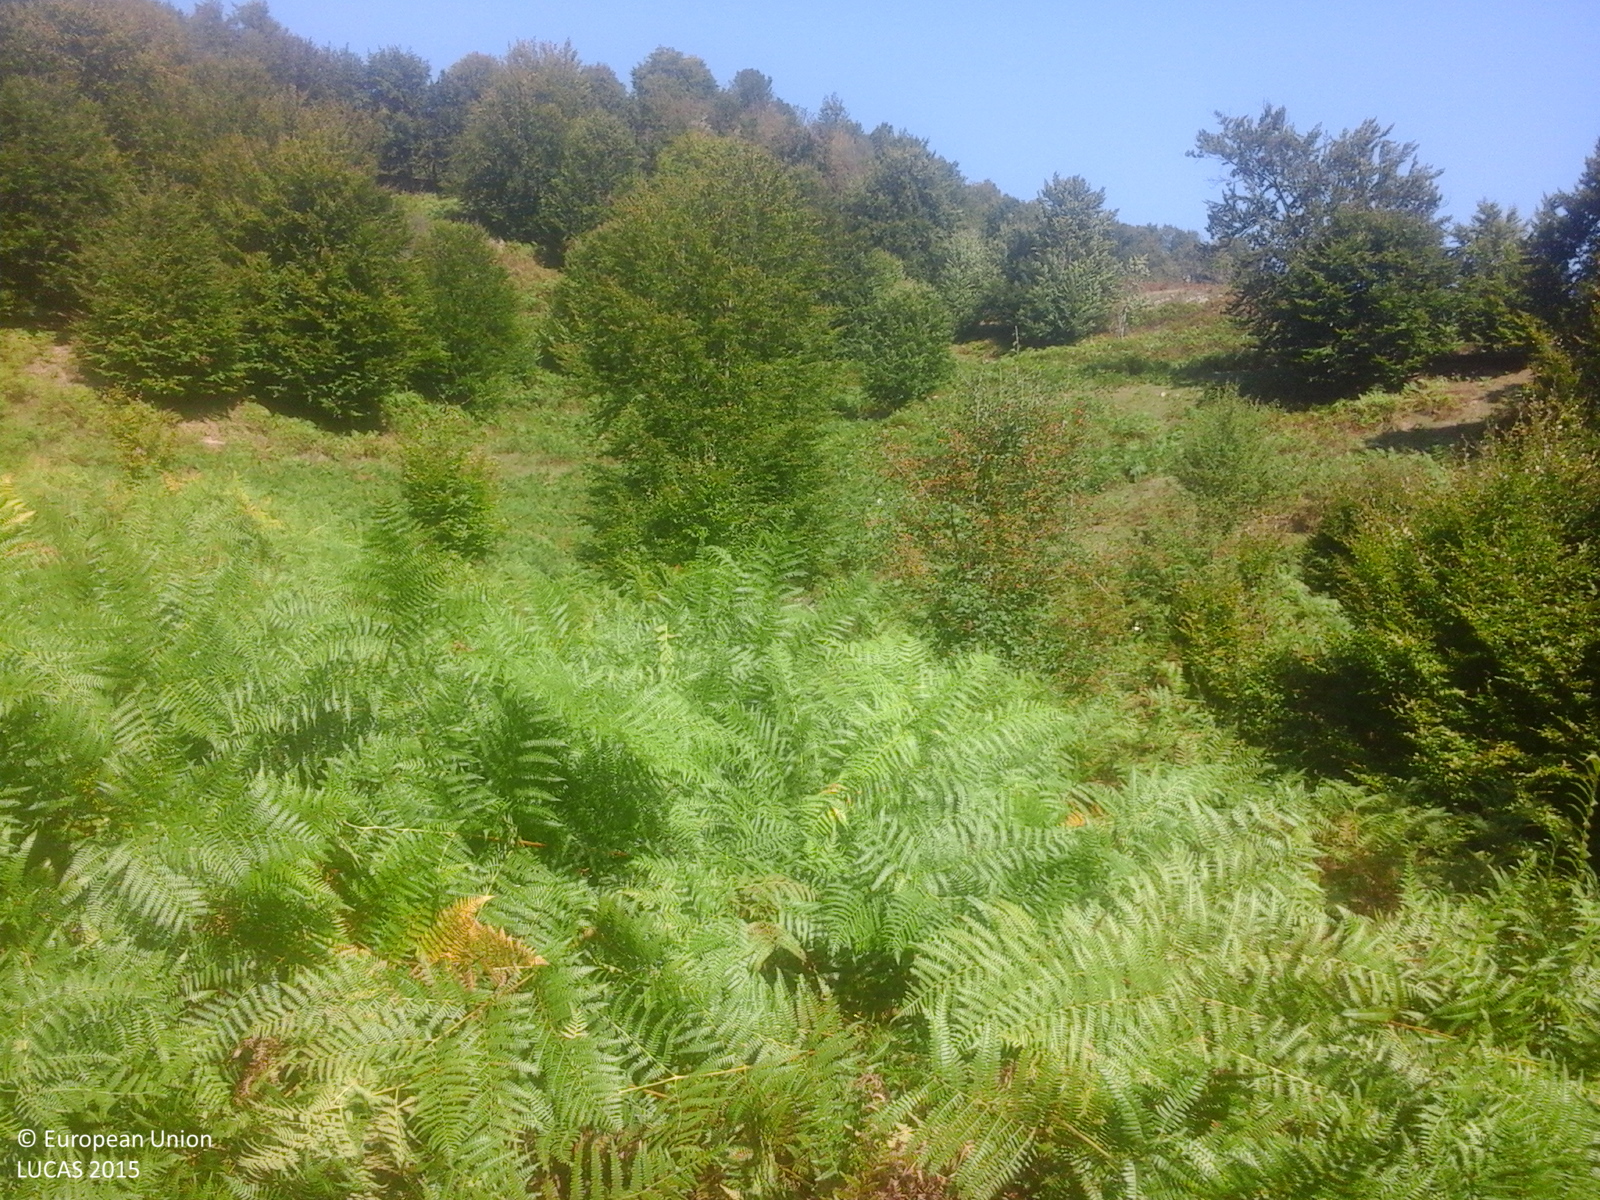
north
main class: Grassland
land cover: Spontaneously vegetated surfaces
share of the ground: > 75 %
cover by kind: herbaceous plants 100 %
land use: Semi-natural and natural areas not in use
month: September
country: RO
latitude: 46.8238
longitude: 22.4396
